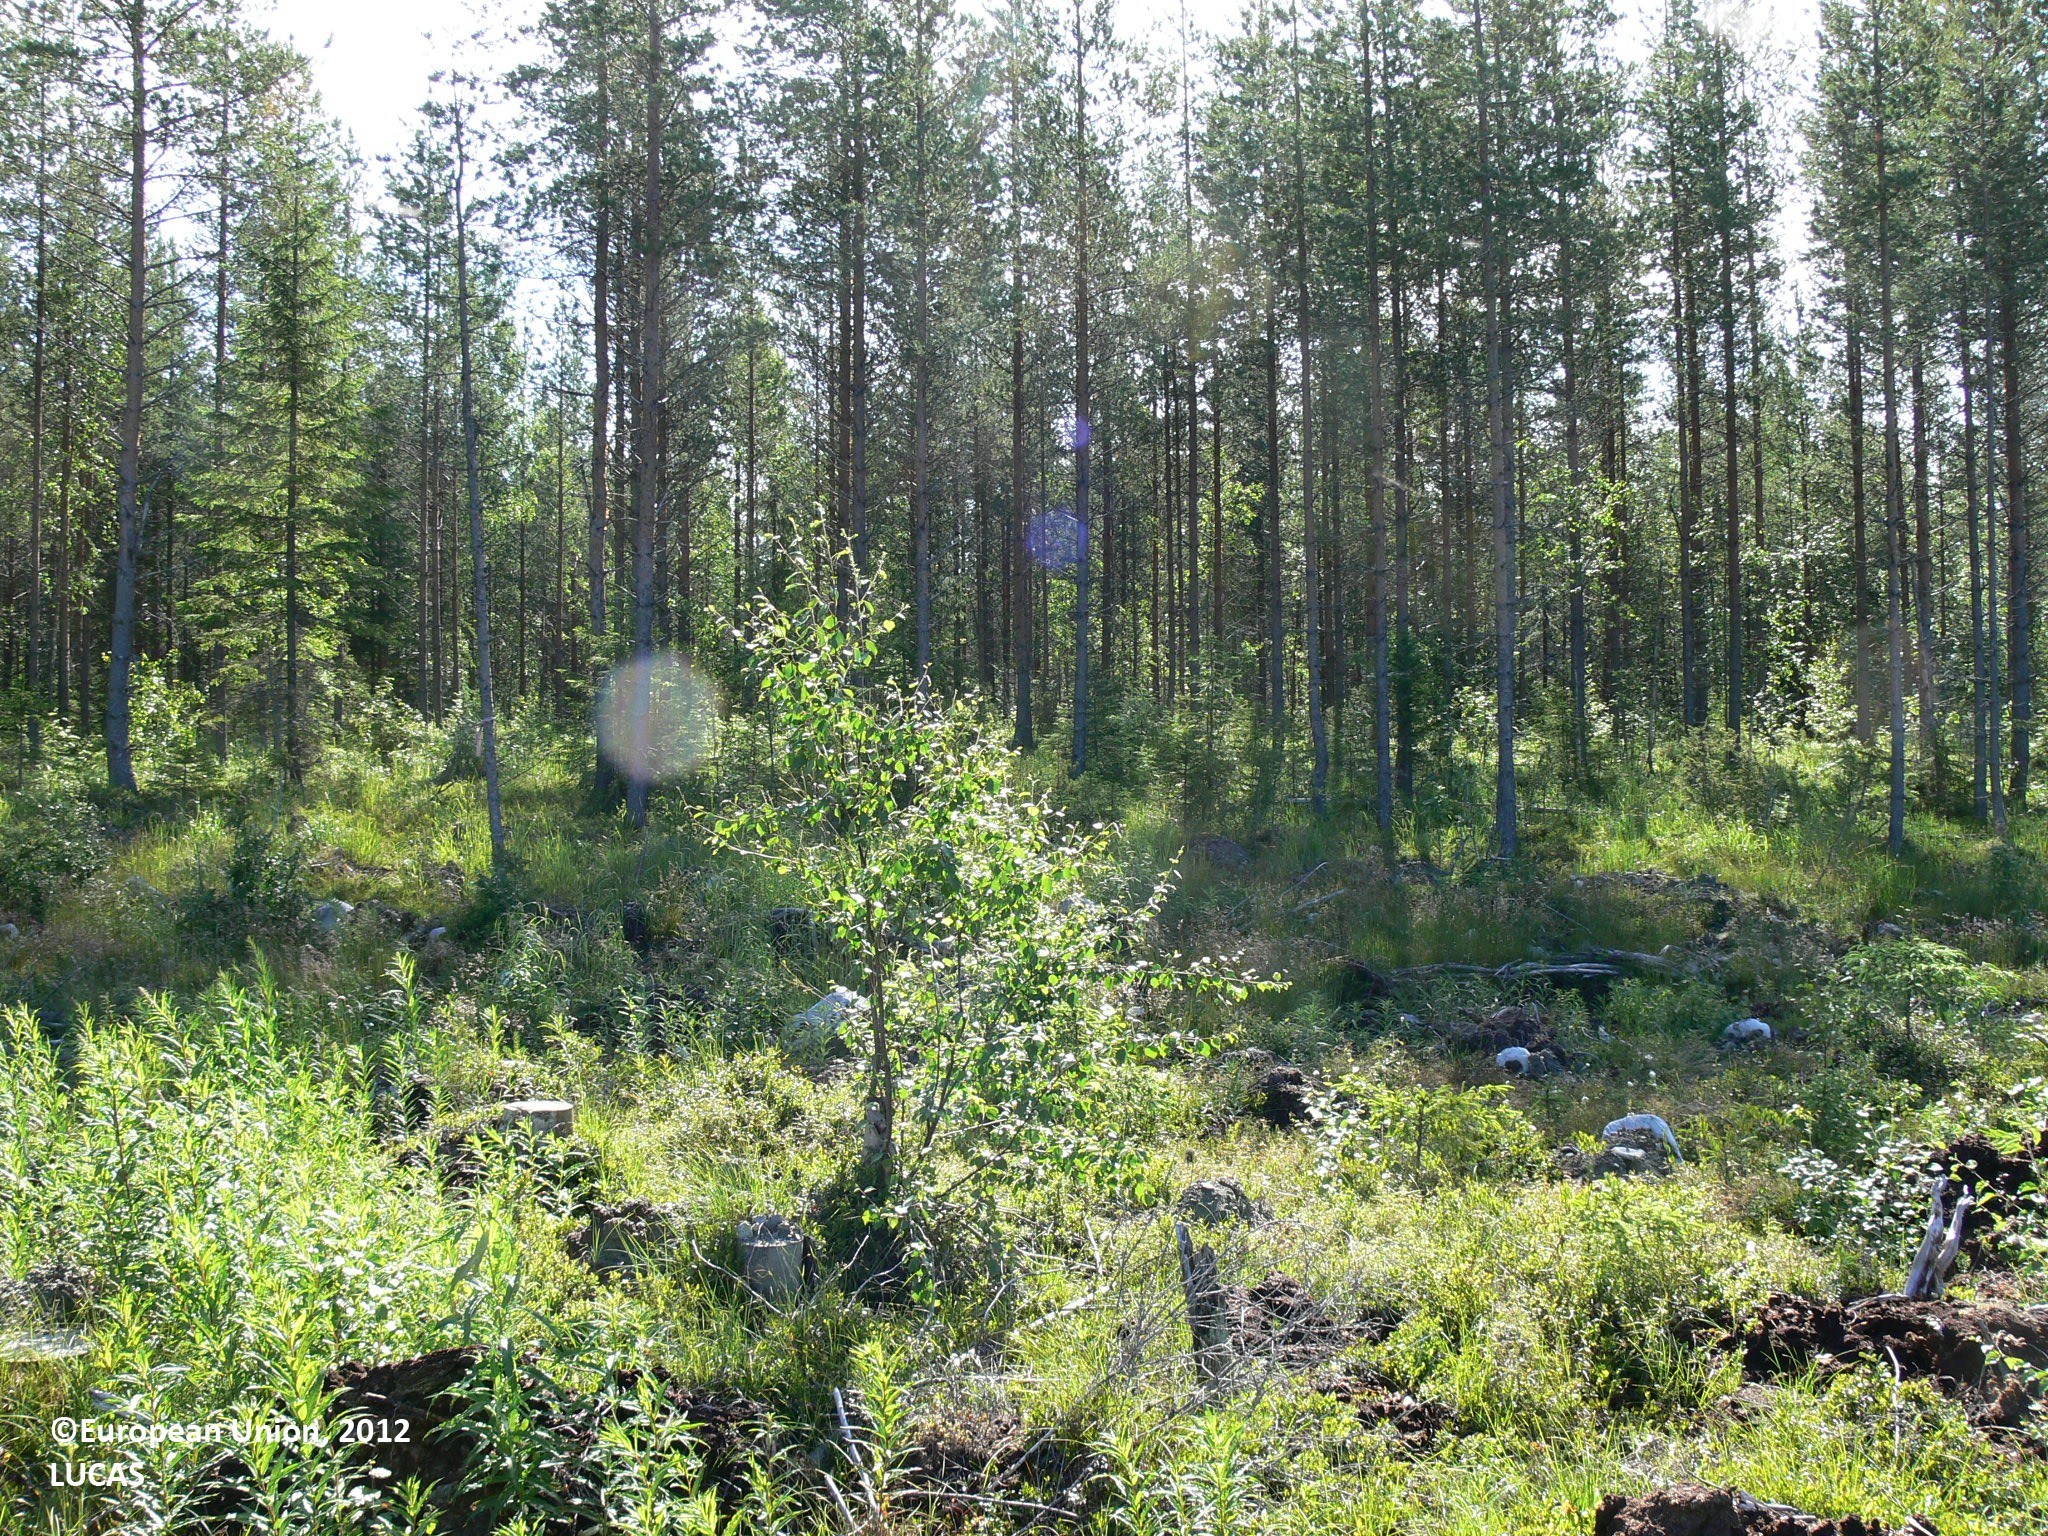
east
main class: Woodland
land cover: Broadleaved woodland
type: boreal forest
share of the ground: 10 - 25 %
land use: Forestry
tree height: < 5 m
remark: Clear cut
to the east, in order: Broadleaved woodland; Ditches and canals; Pine dominated coniferous woodland; Ditches and canals; Pine dominated coniferous woodland; Other coniferous woodland; Ditches and canals; Other coniferous woodland; Pine dominated coniferous woodland; Shruby margins; Ditches and canals; Grass margins; Paved roads, cycling and walking lanes; Grass margins; Other coniferous woodland
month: July
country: FI
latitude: 62.8896
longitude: 29.9013
